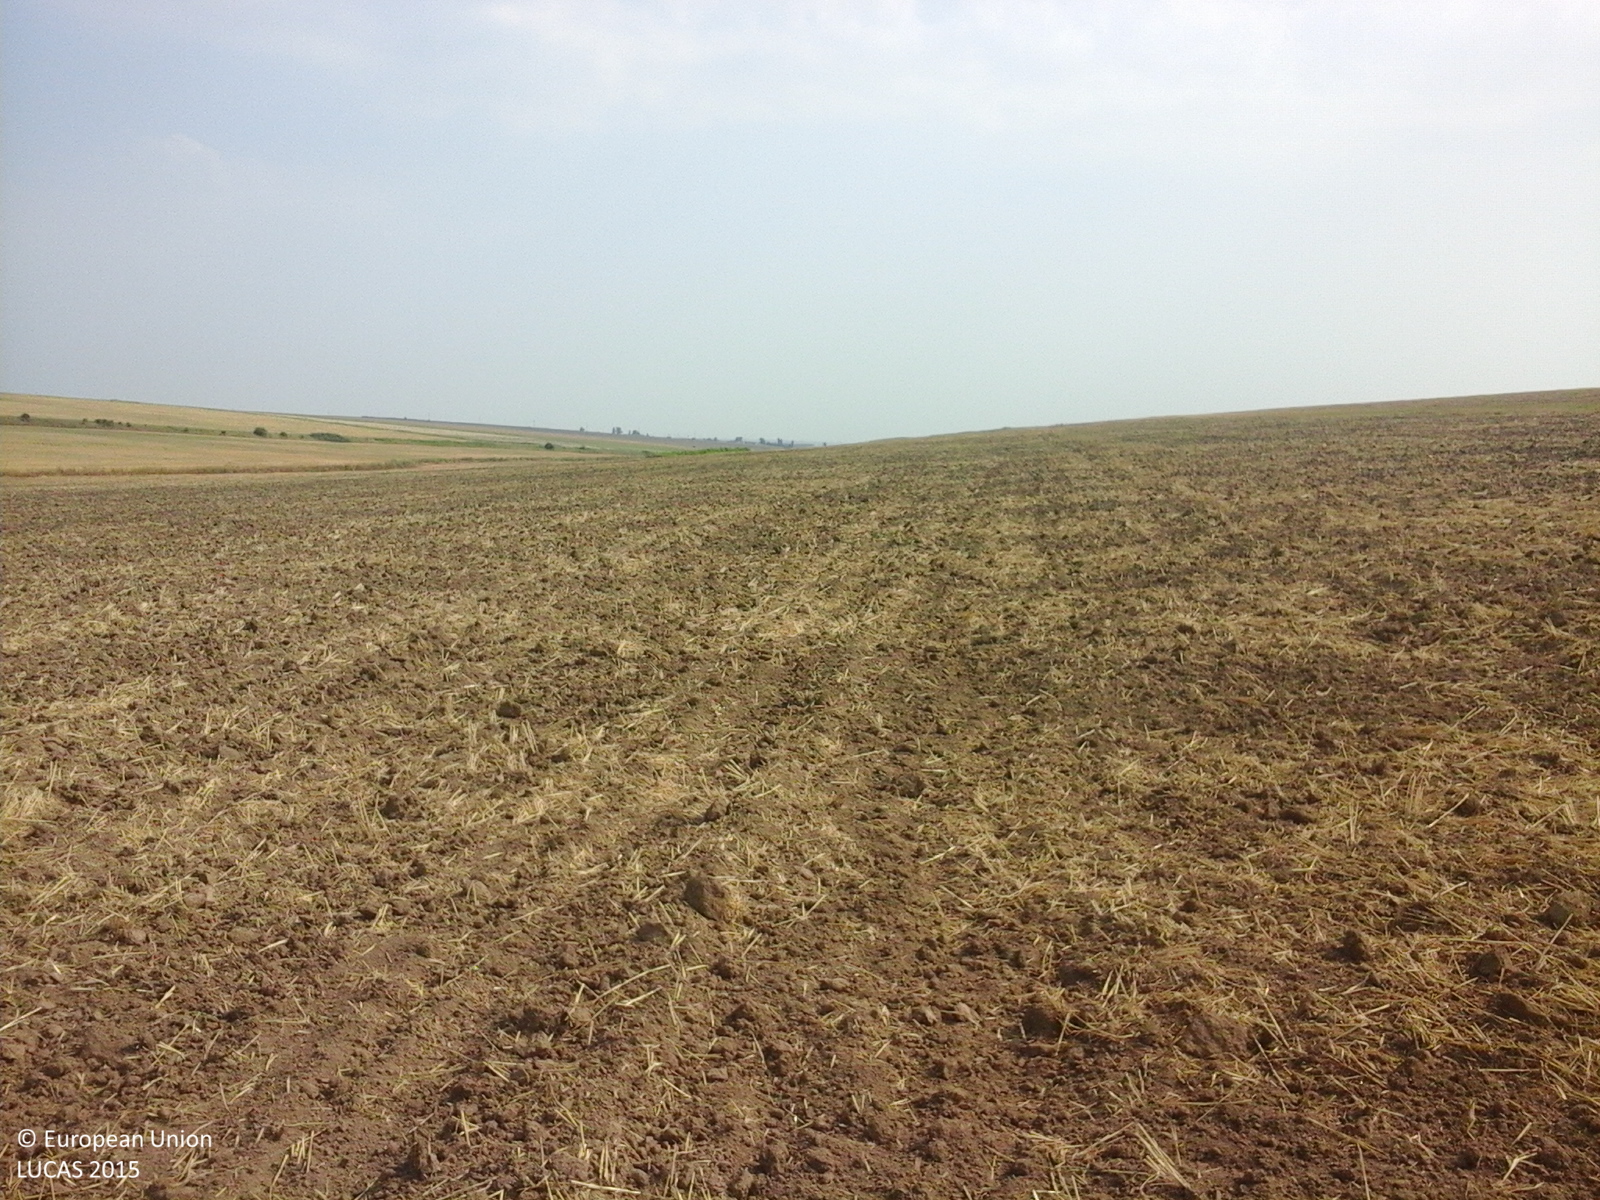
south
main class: Cropland
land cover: Common wheat
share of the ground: 10 - 25 %
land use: Agriculture (excluding fallow land and kitchen gardens)
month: July
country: RO
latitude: 45.4562
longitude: 27.8755
